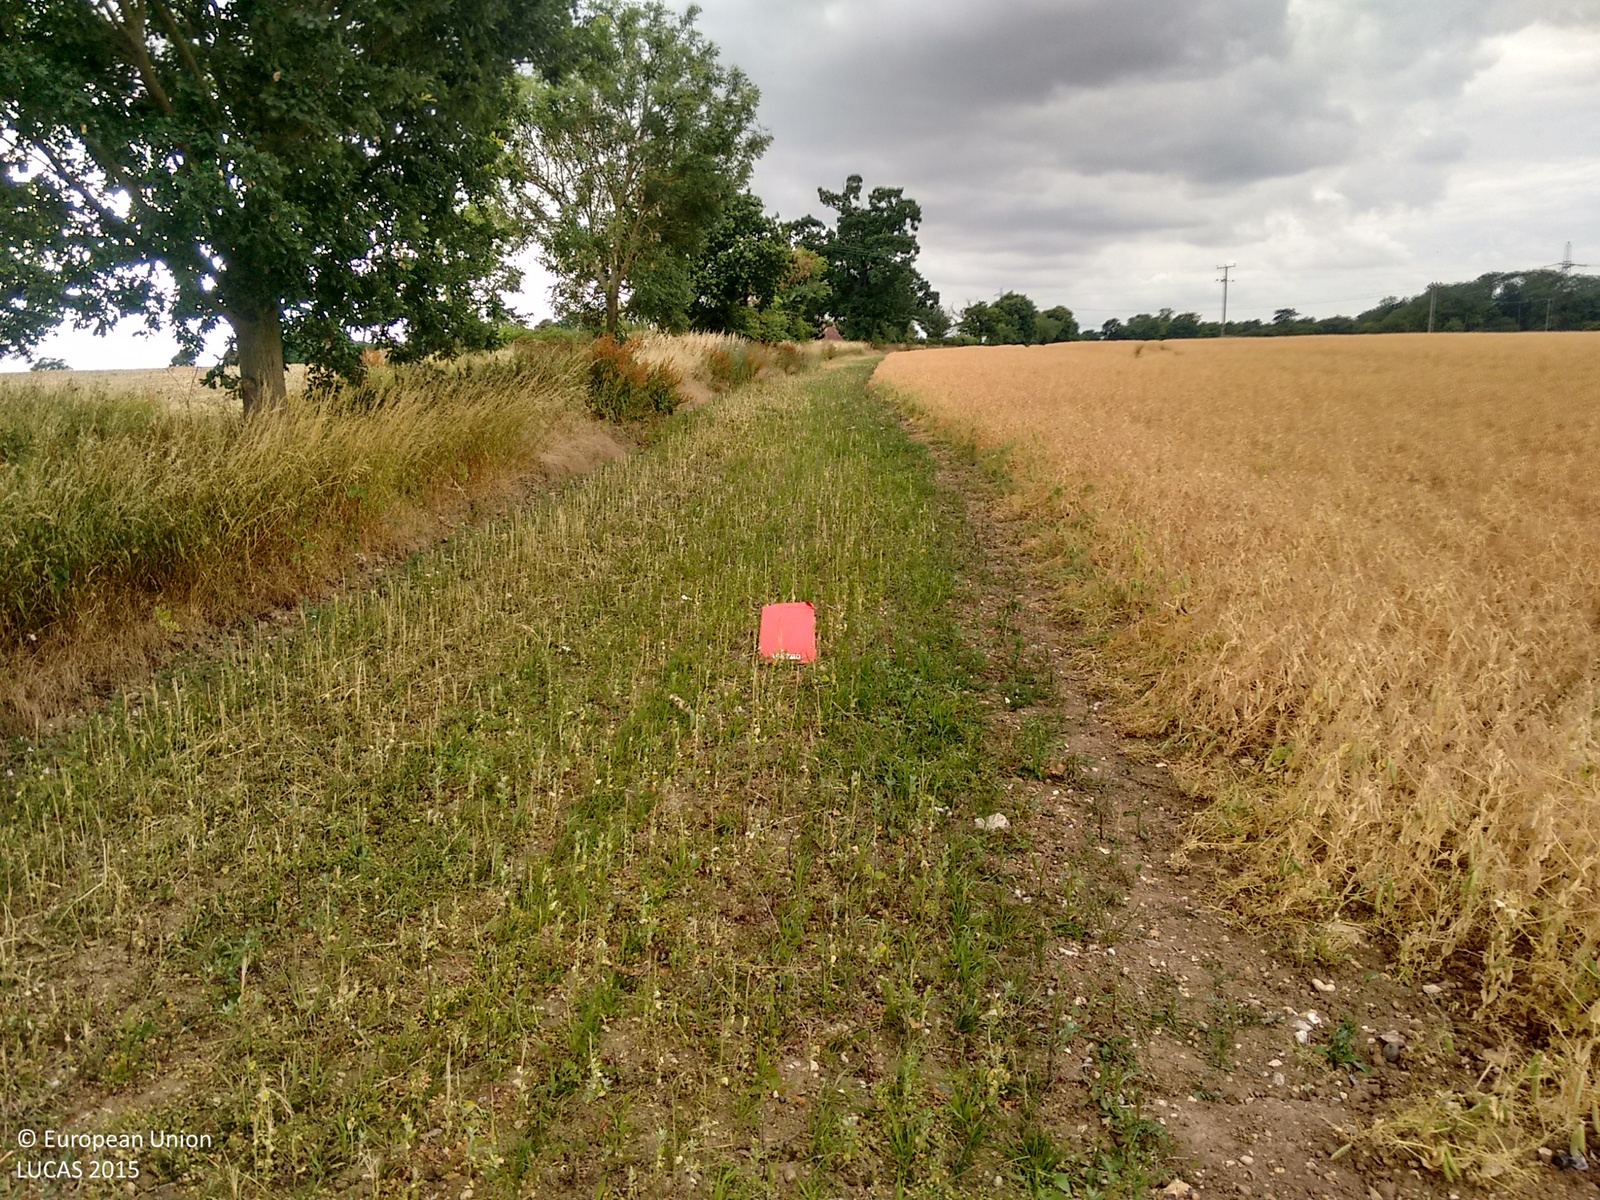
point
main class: Grassland
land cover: Spontaneously vegetated surfaces
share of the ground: 25 - 50 %
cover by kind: herbaceous plants 100 %
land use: Fallow land
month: July
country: GB
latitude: 51.8193
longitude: 0.5575
